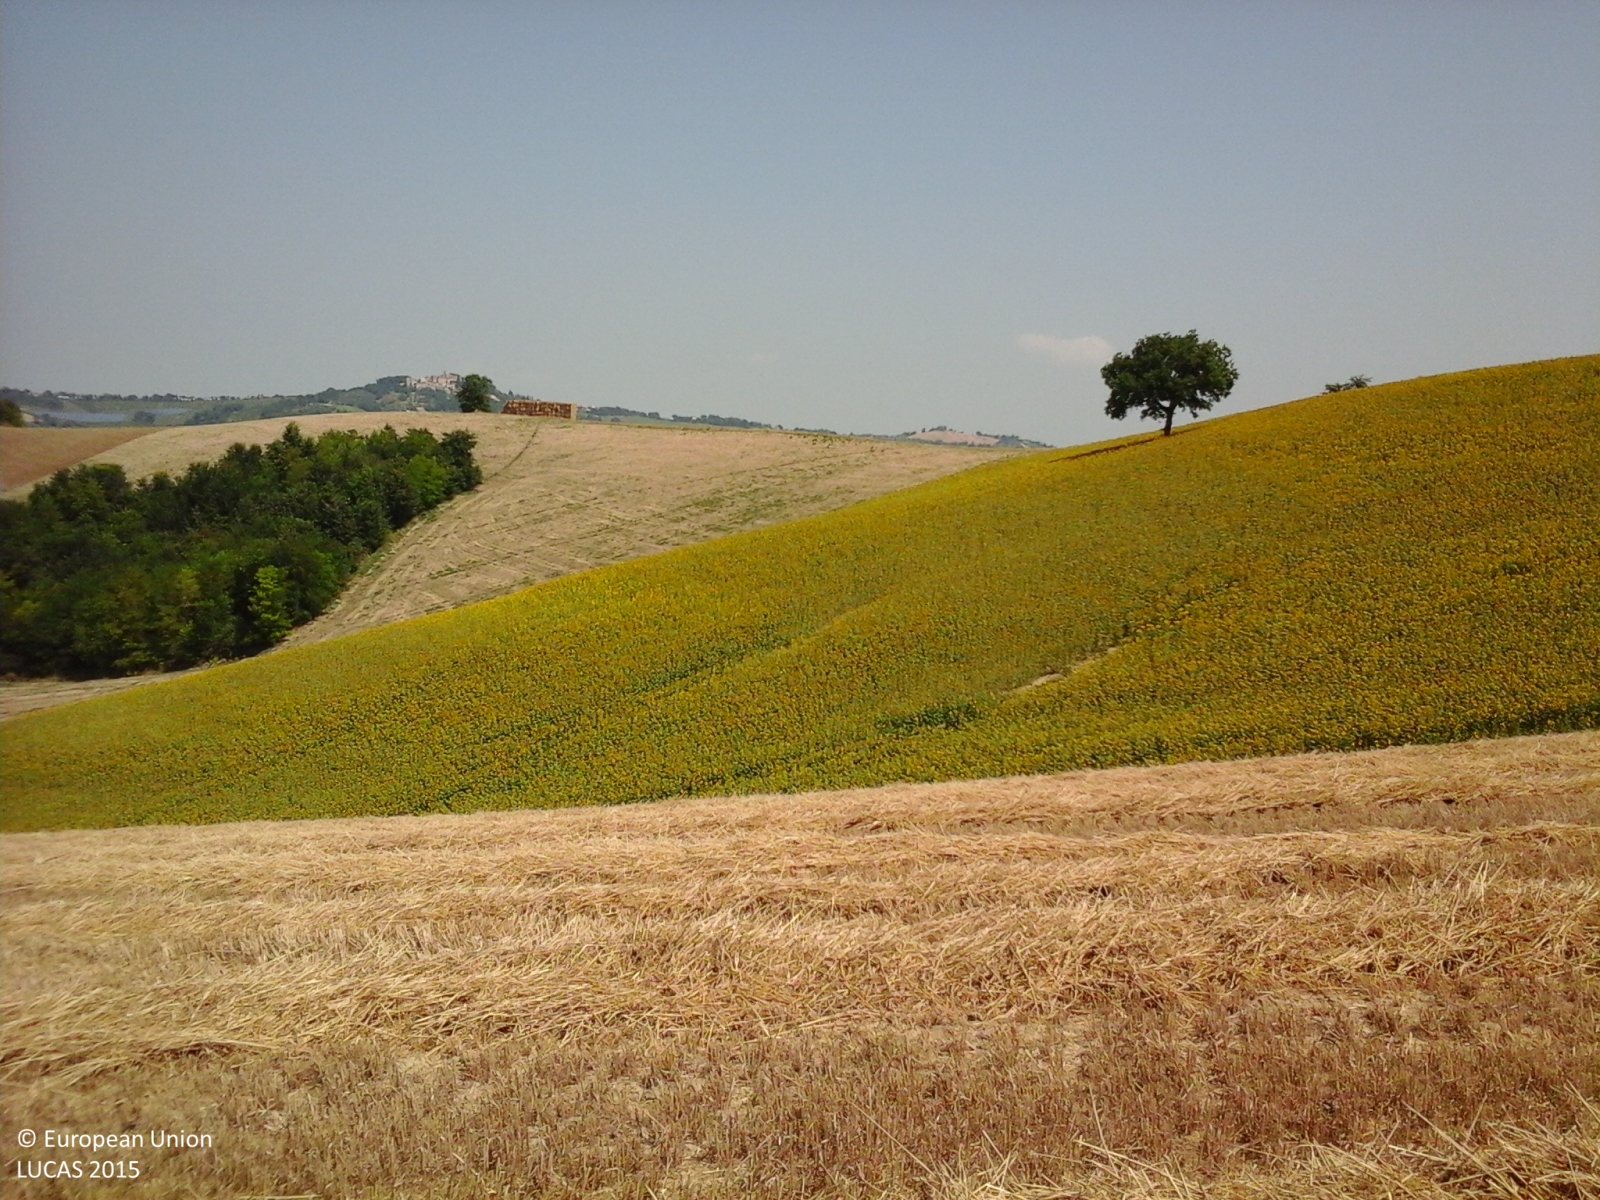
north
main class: Cropland
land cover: Durum wheat
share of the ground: > 75 %
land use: Agriculture (excluding fallow land and kitchen gardens)
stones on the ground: < 10 %
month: July
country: IT
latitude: 43.0226
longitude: 13.6347
